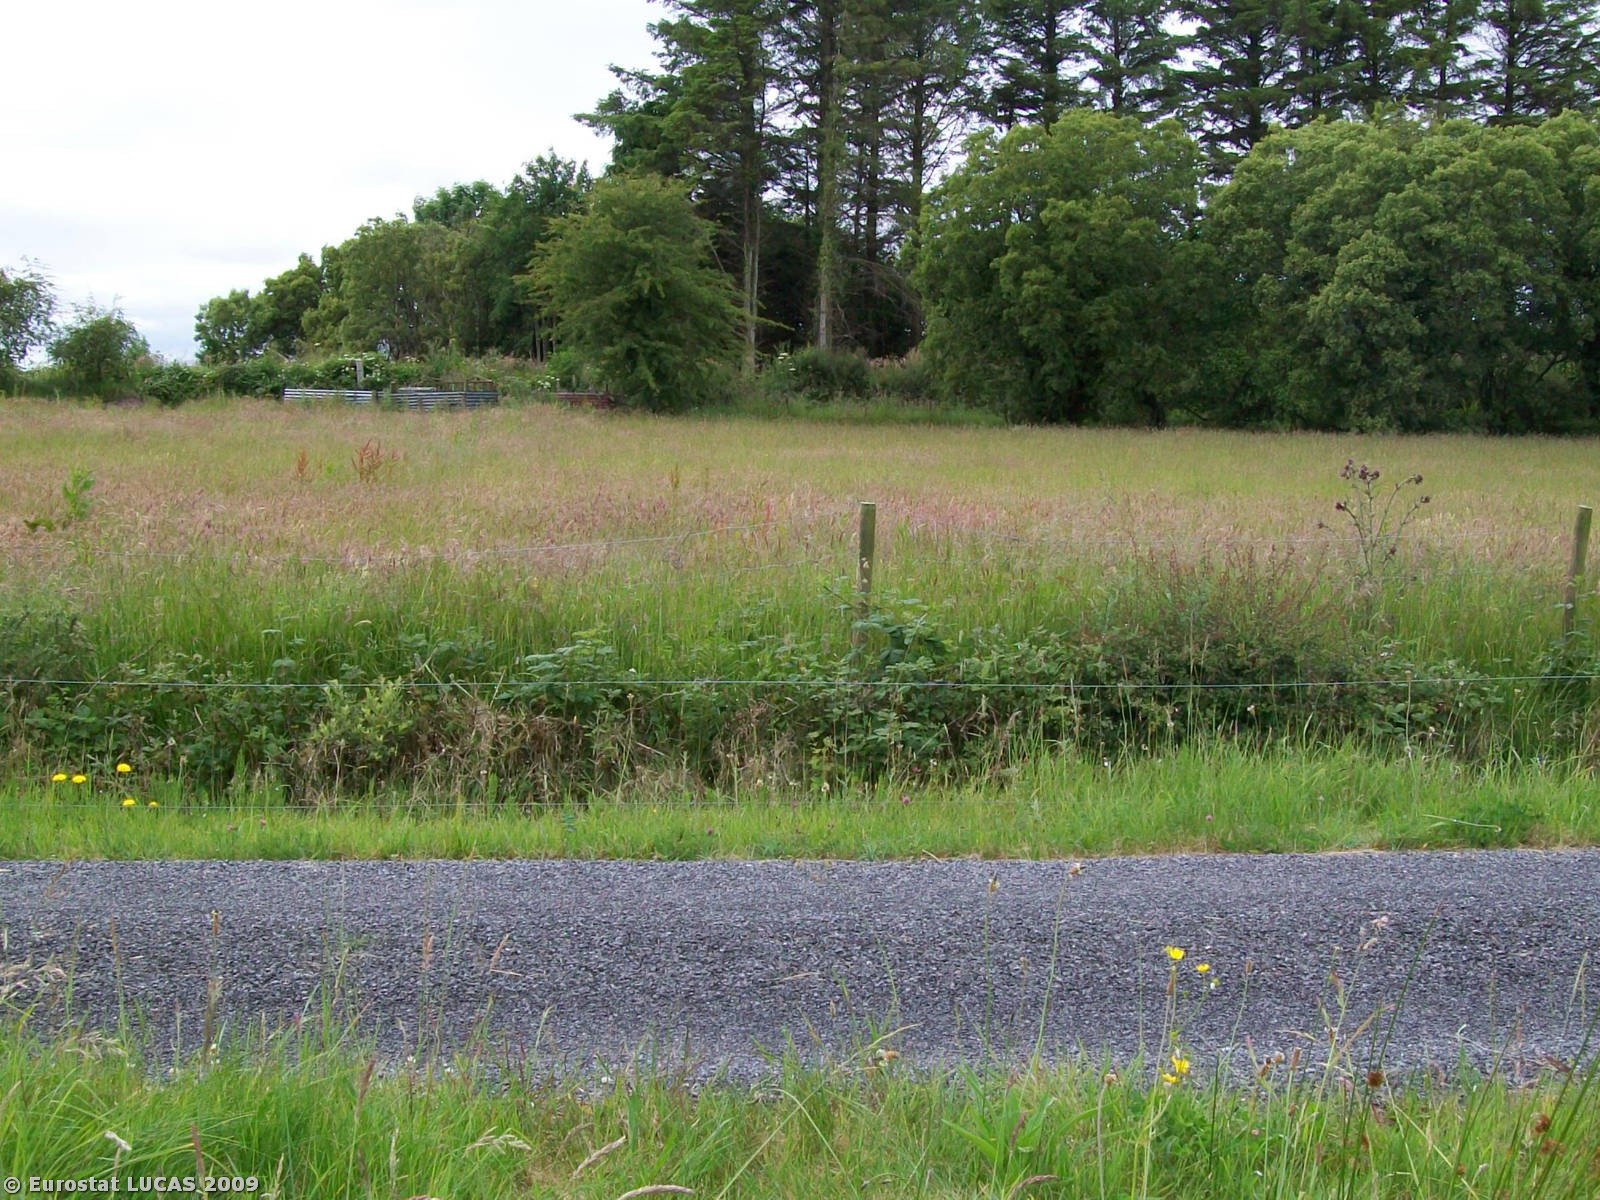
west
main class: Grassland
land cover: Grassland without tree/shrub cover
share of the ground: > 75 %
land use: Agriculture (excluding fallow land and kitchen gardens)
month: June
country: IE
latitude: 53.7808
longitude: -9.0156
